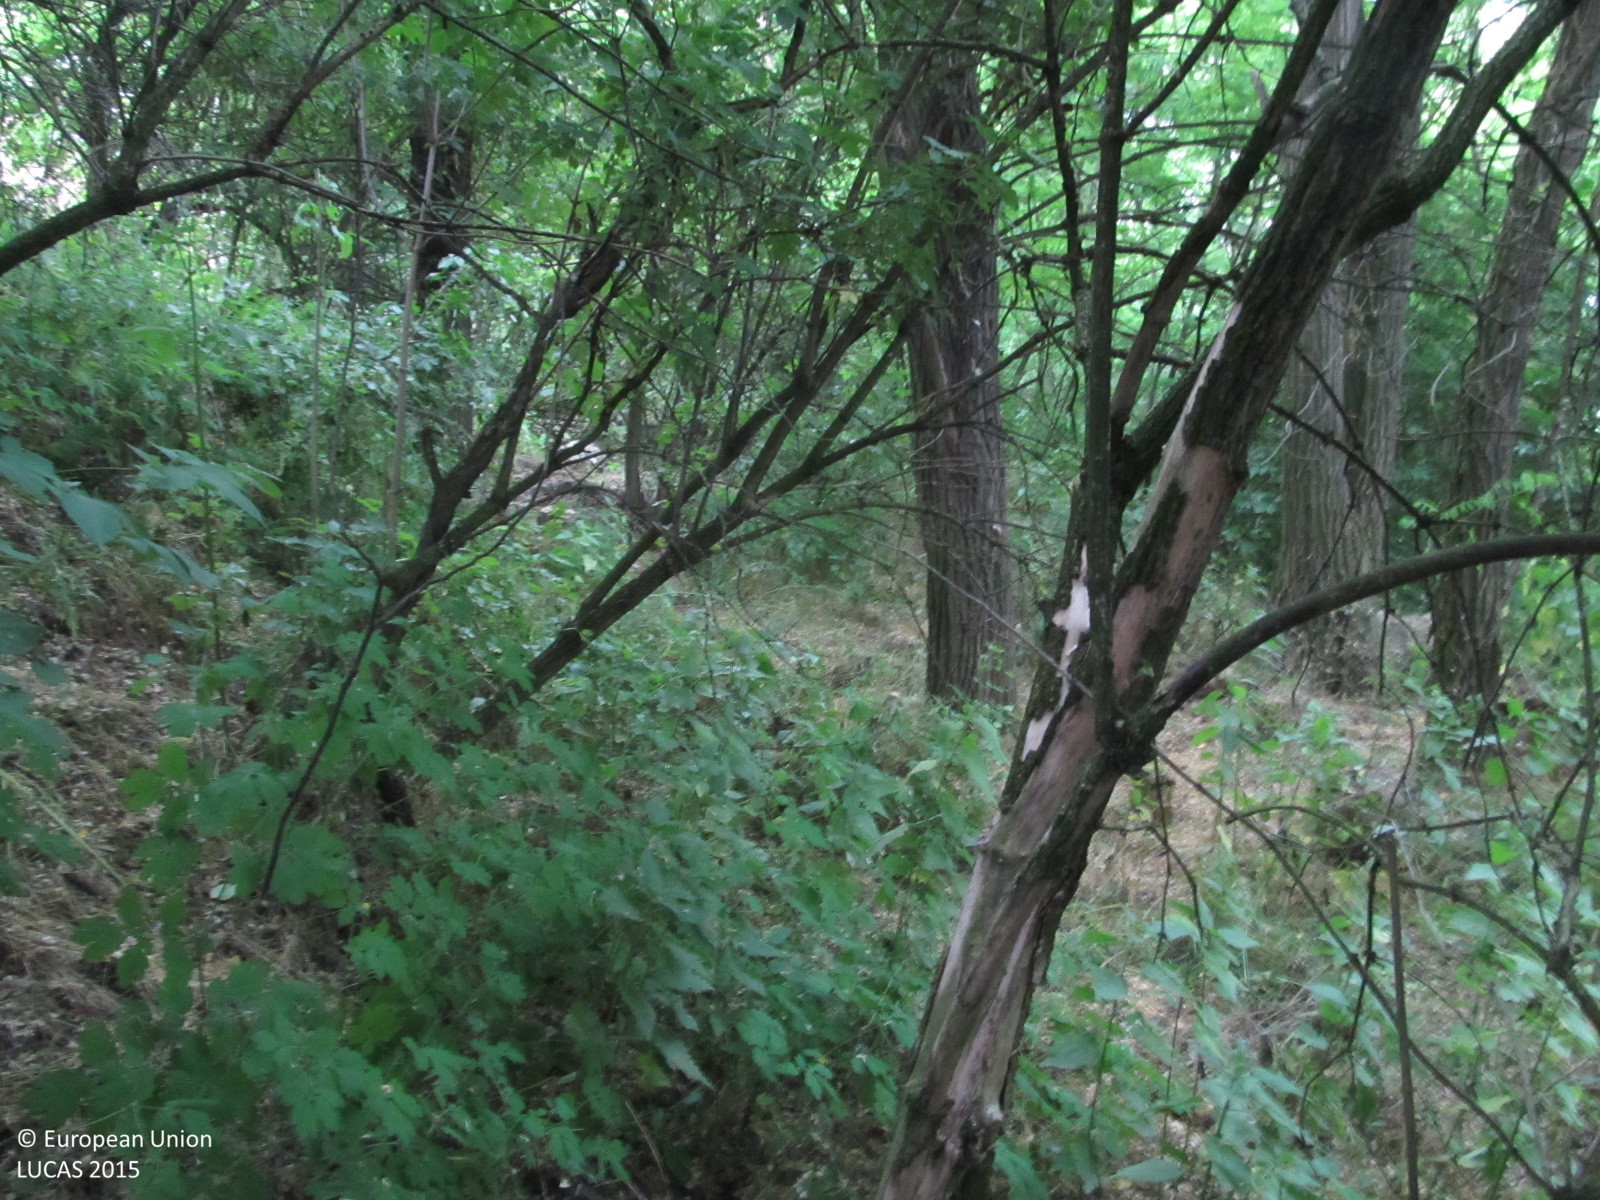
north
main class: Woodland
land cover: Broadleaved woodland
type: exotic forest
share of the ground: > 75 %
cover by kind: broadleaved forest trees 80 %, shrubs 10 %, herbaceous plants 10 %
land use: Semi-natural and natural areas not in use
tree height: > 5 m
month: June
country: AT
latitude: 48.2659
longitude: 15.8637
